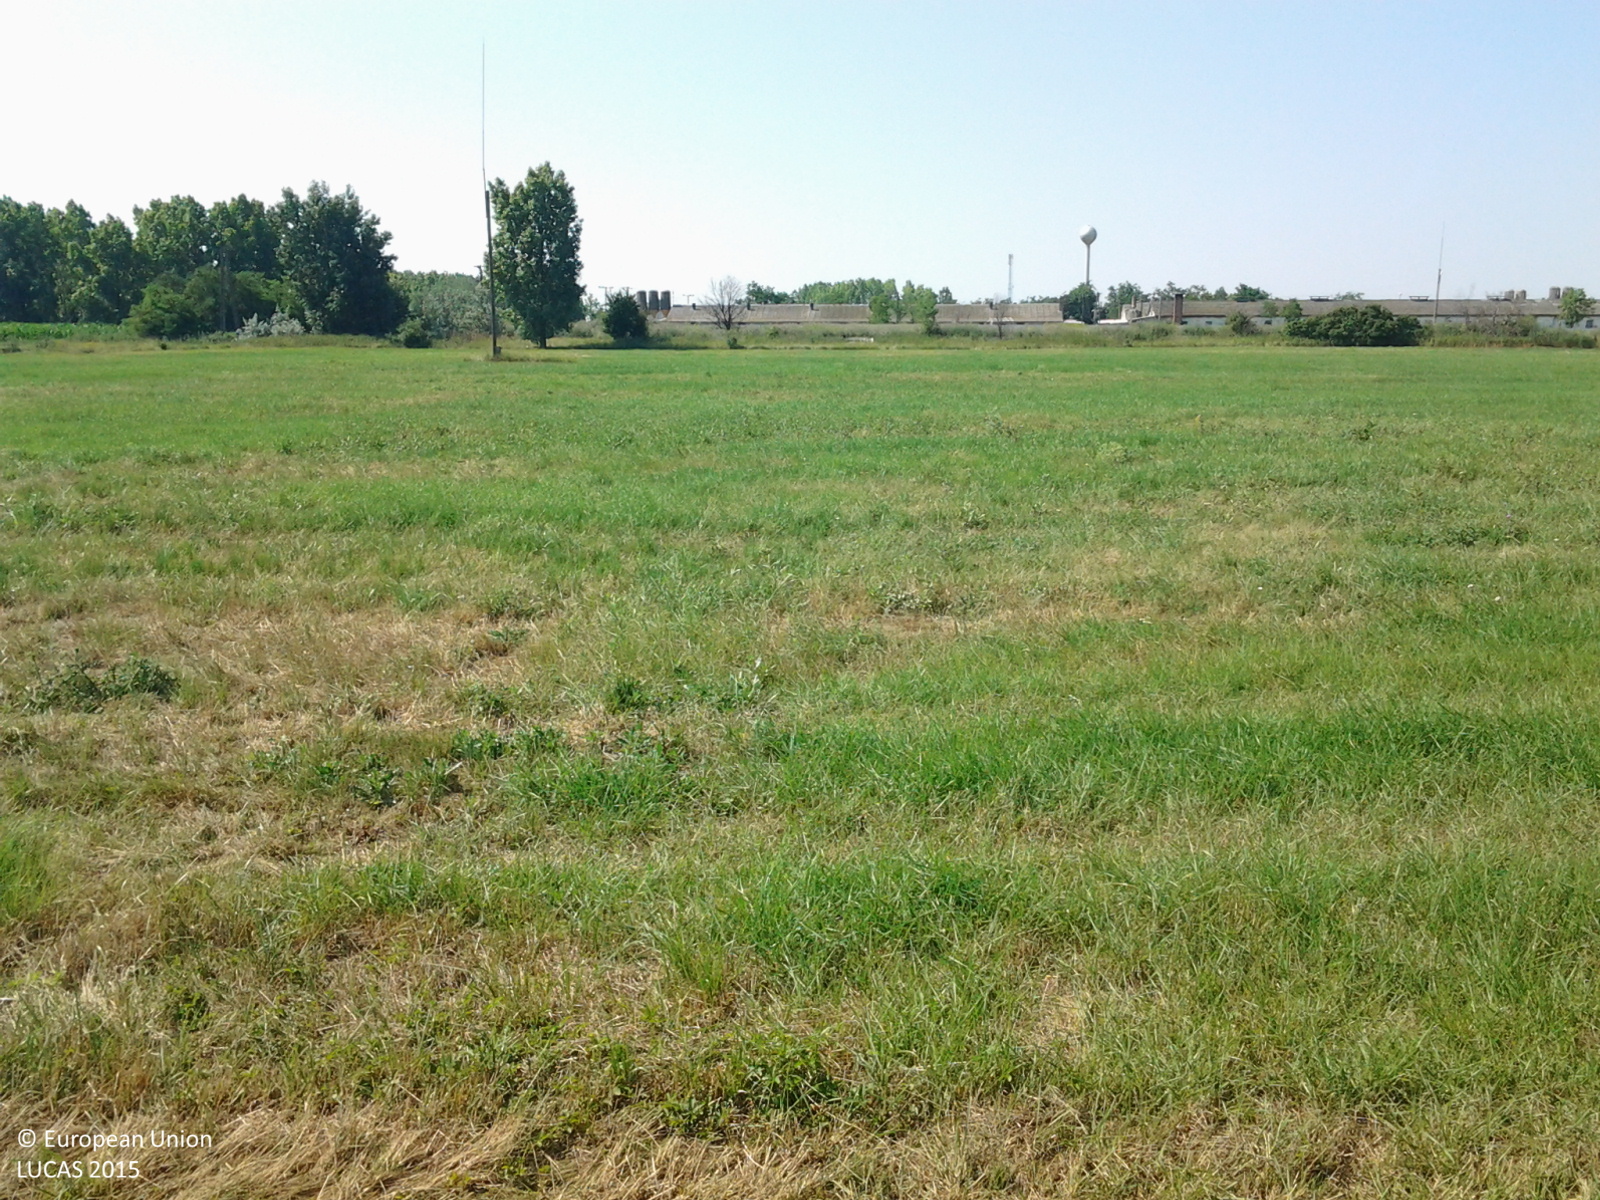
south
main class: Grassland
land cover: Grassland without tree/shrub cover
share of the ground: > 75 %
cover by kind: herbaceous plants 100 %
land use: Agriculture (excluding fallow land and kitchen gardens)
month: July
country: HU
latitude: 47.6614
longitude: 19.9734
